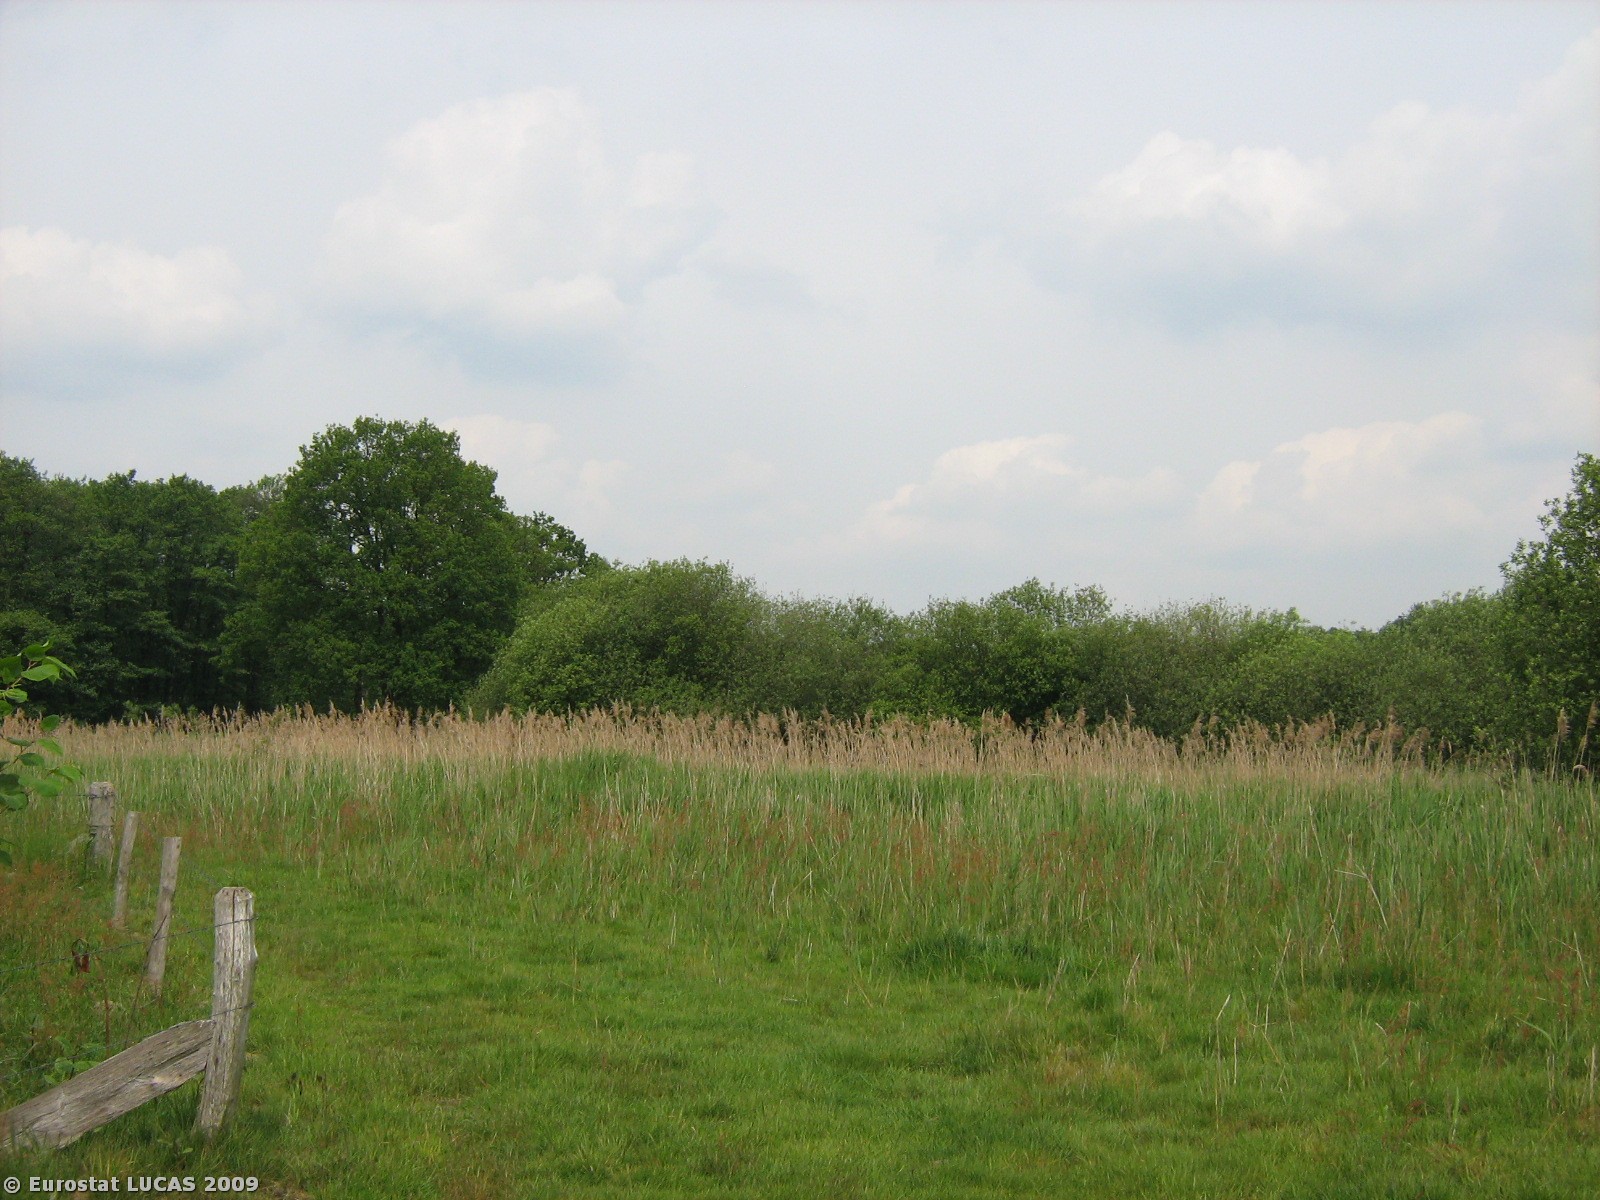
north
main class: Grassland
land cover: Grassland without tree/shrub cover
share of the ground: > 75 %
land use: Nature reserves
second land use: Agriculture (excluding fallow land and kitchen gardens)
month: May
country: NL
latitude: 51.3001
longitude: 5.4514
